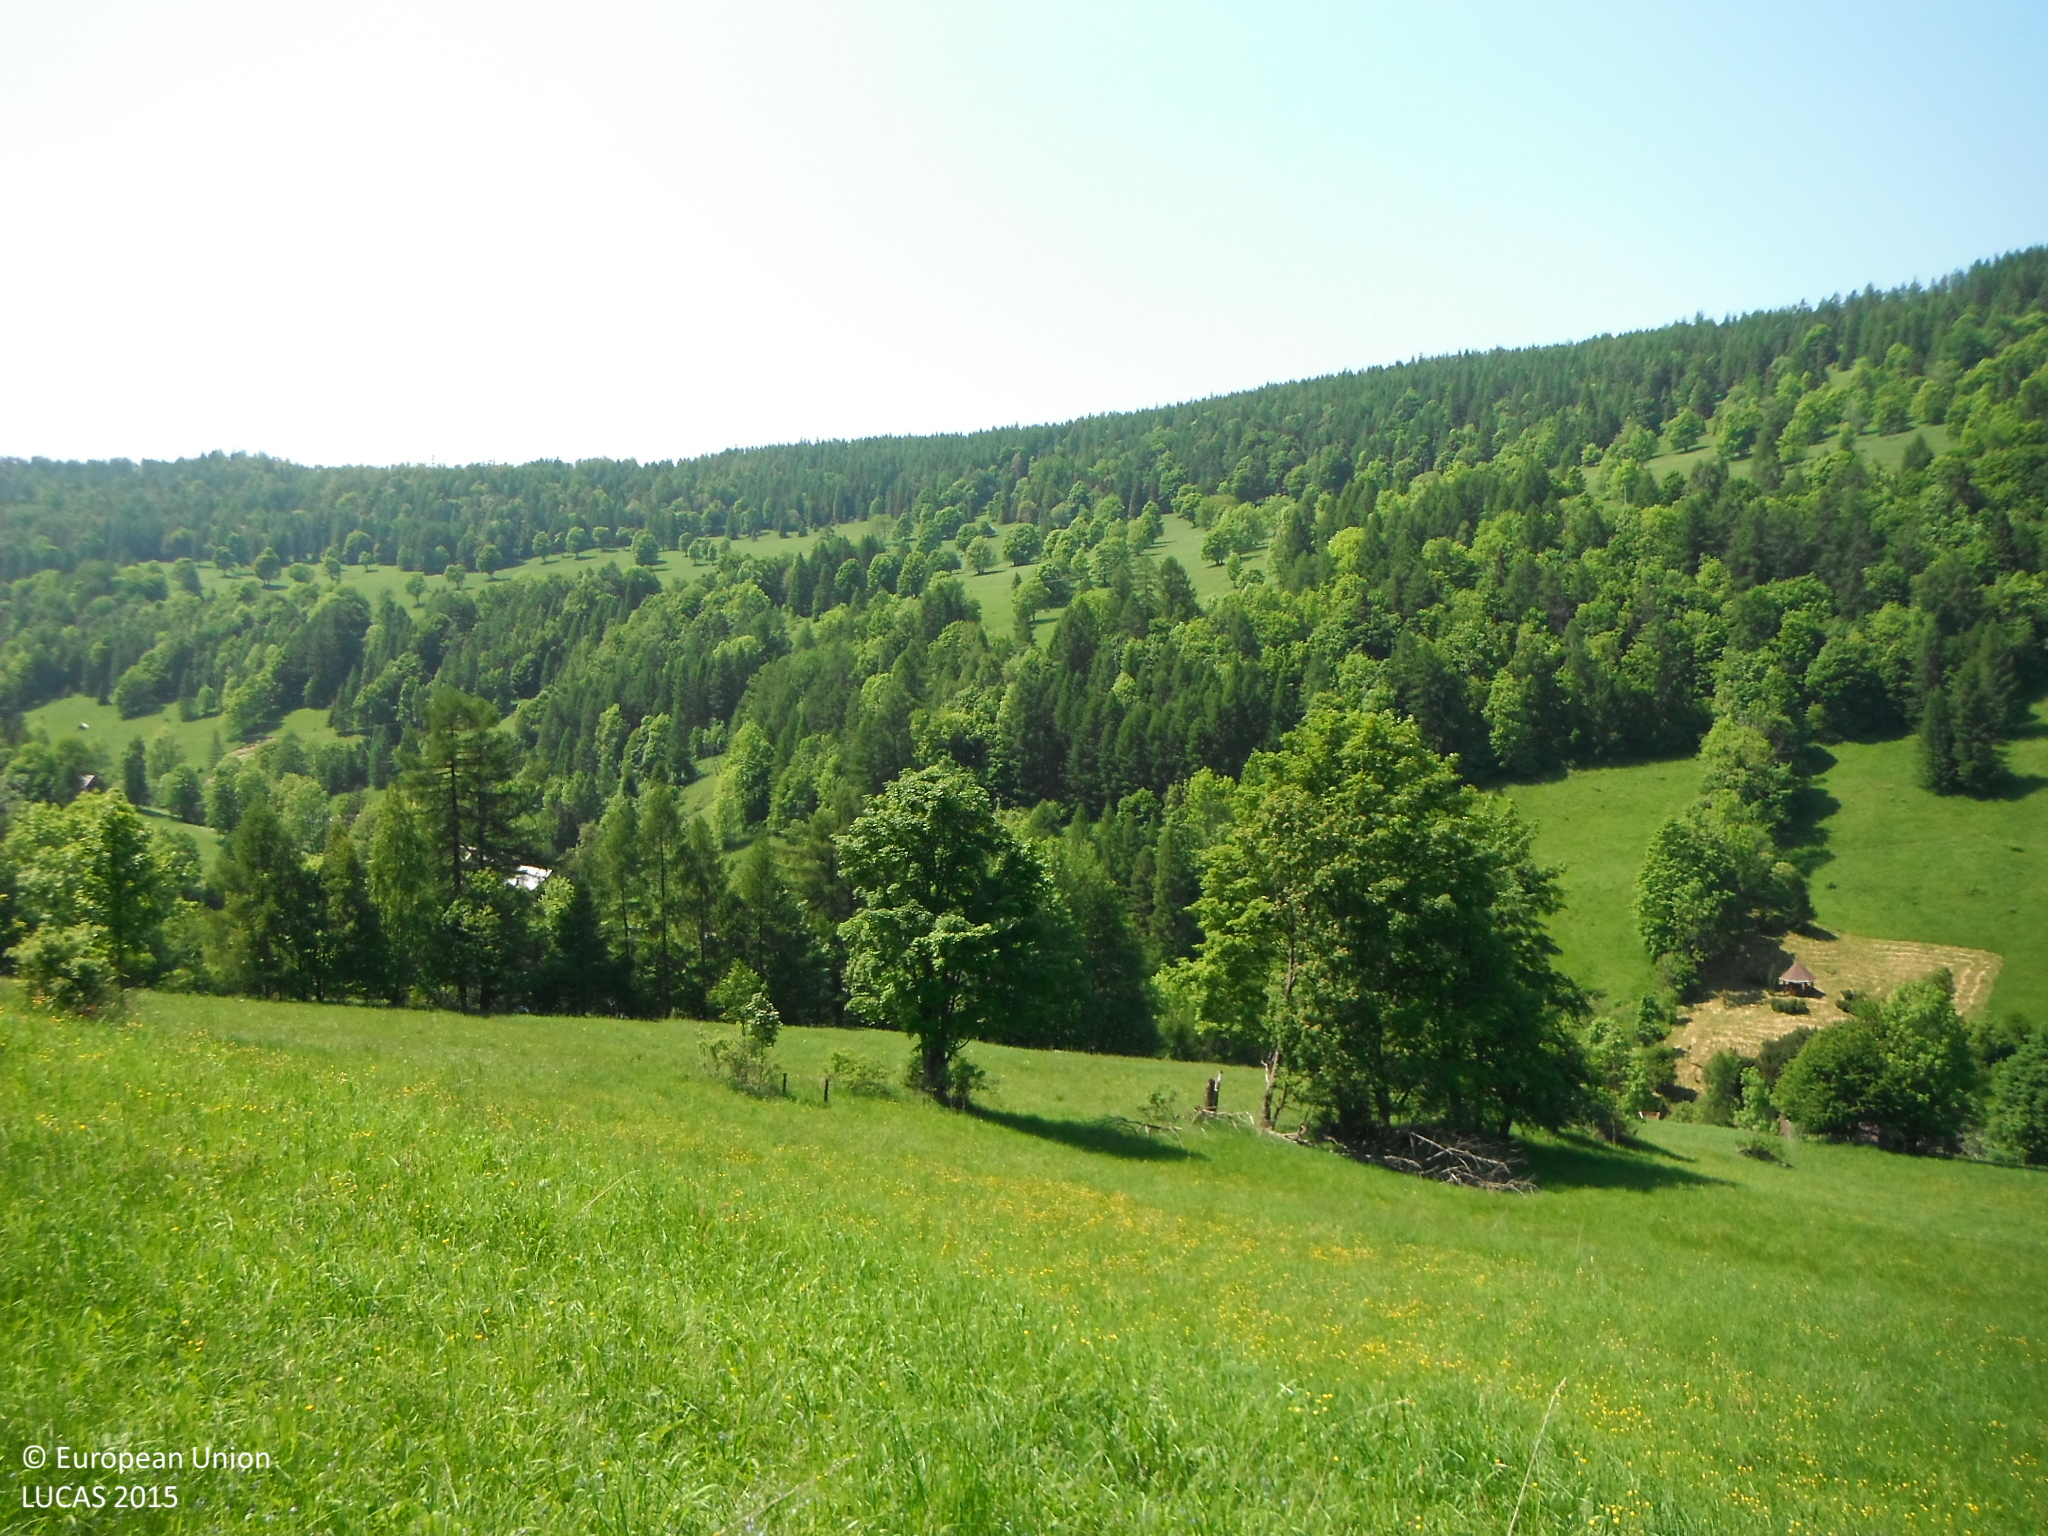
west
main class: Grassland
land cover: Grassland without tree/shrub cover
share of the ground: > 75 %
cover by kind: herbaceous plants 100 %
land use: Agriculture (excluding fallow land and kitchen gardens)
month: June
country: SK
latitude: 49.2963
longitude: 20.3341
